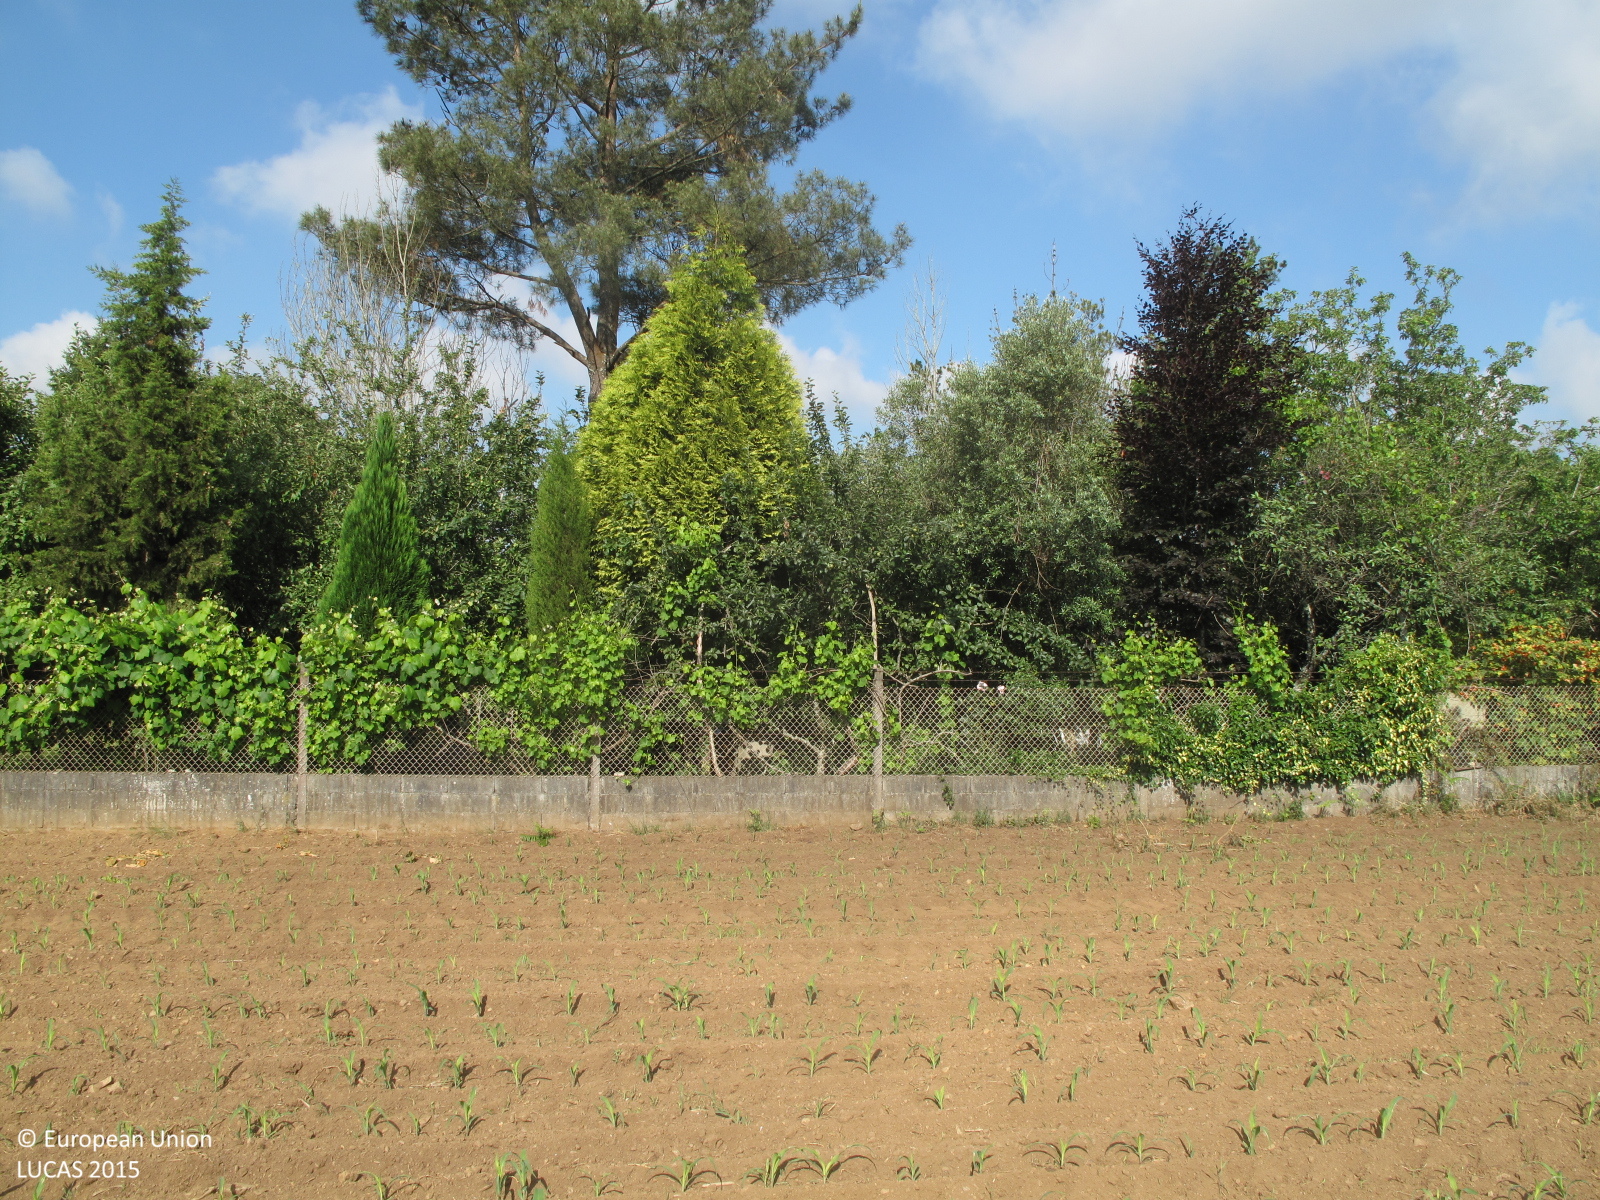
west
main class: Cropland
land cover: Maize
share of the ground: < 10 %
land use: Agriculture (excluding fallow land and kitchen gardens)
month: June
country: ES
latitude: 42.9025
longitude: -8.4361
